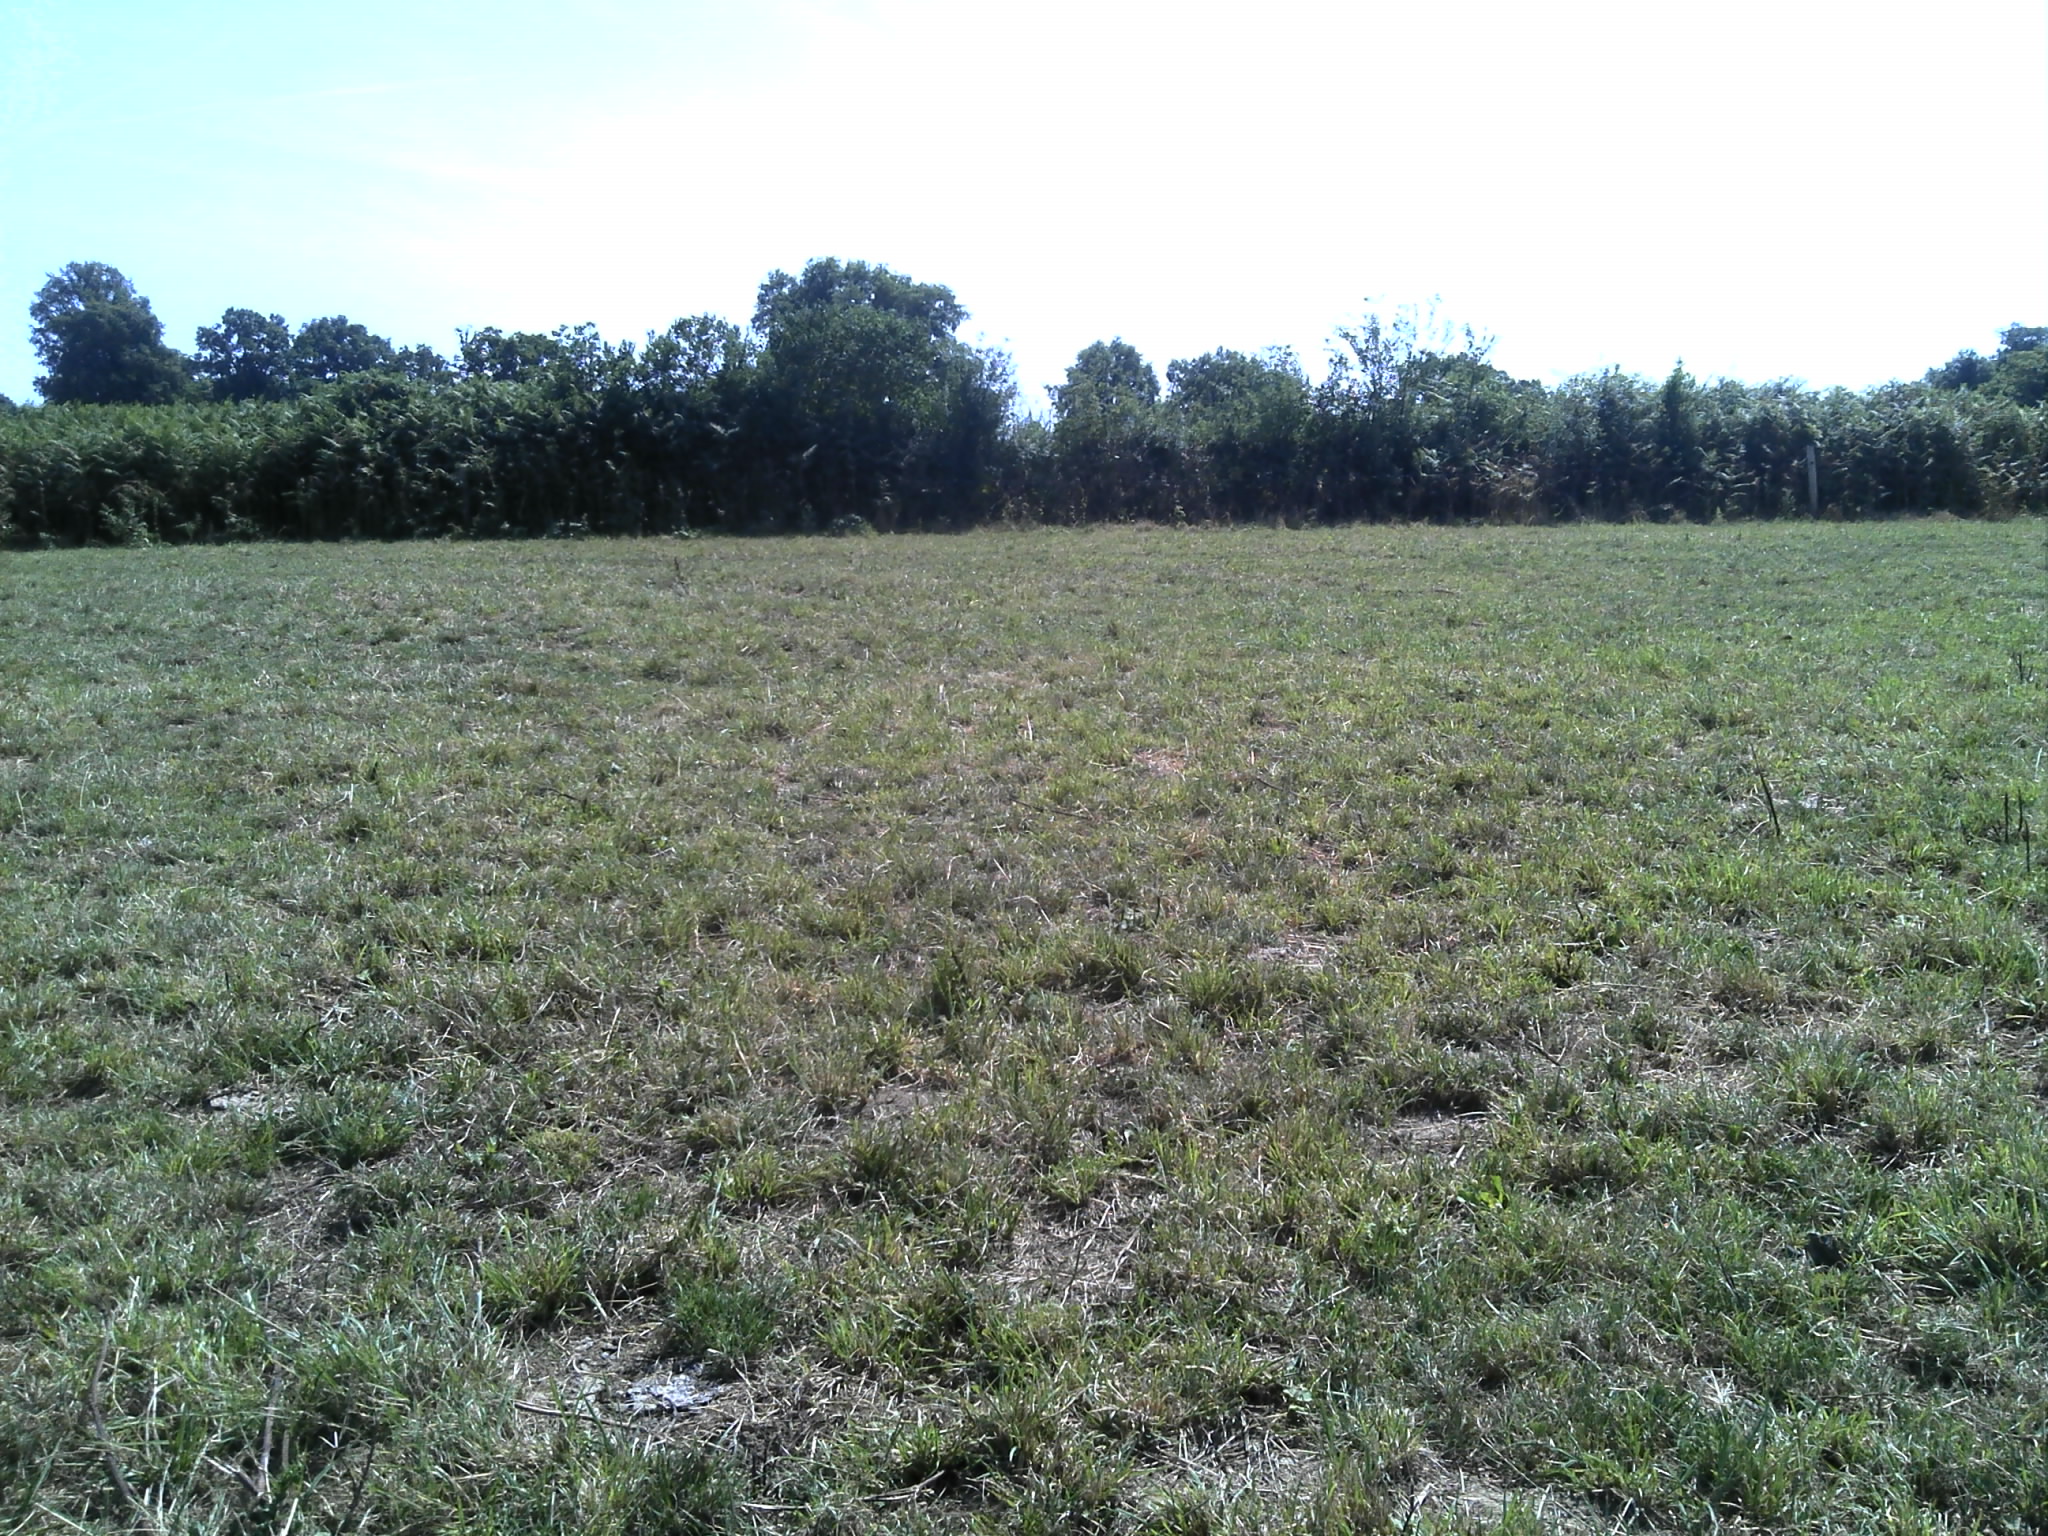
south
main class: Grassland
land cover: Grassland without tree/shrub cover
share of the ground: > 75 %
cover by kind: herbaceous plants 100 %
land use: Agriculture (excluding fallow land and kitchen gardens)
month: August
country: FR
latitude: 46.4803
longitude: 1.6937
